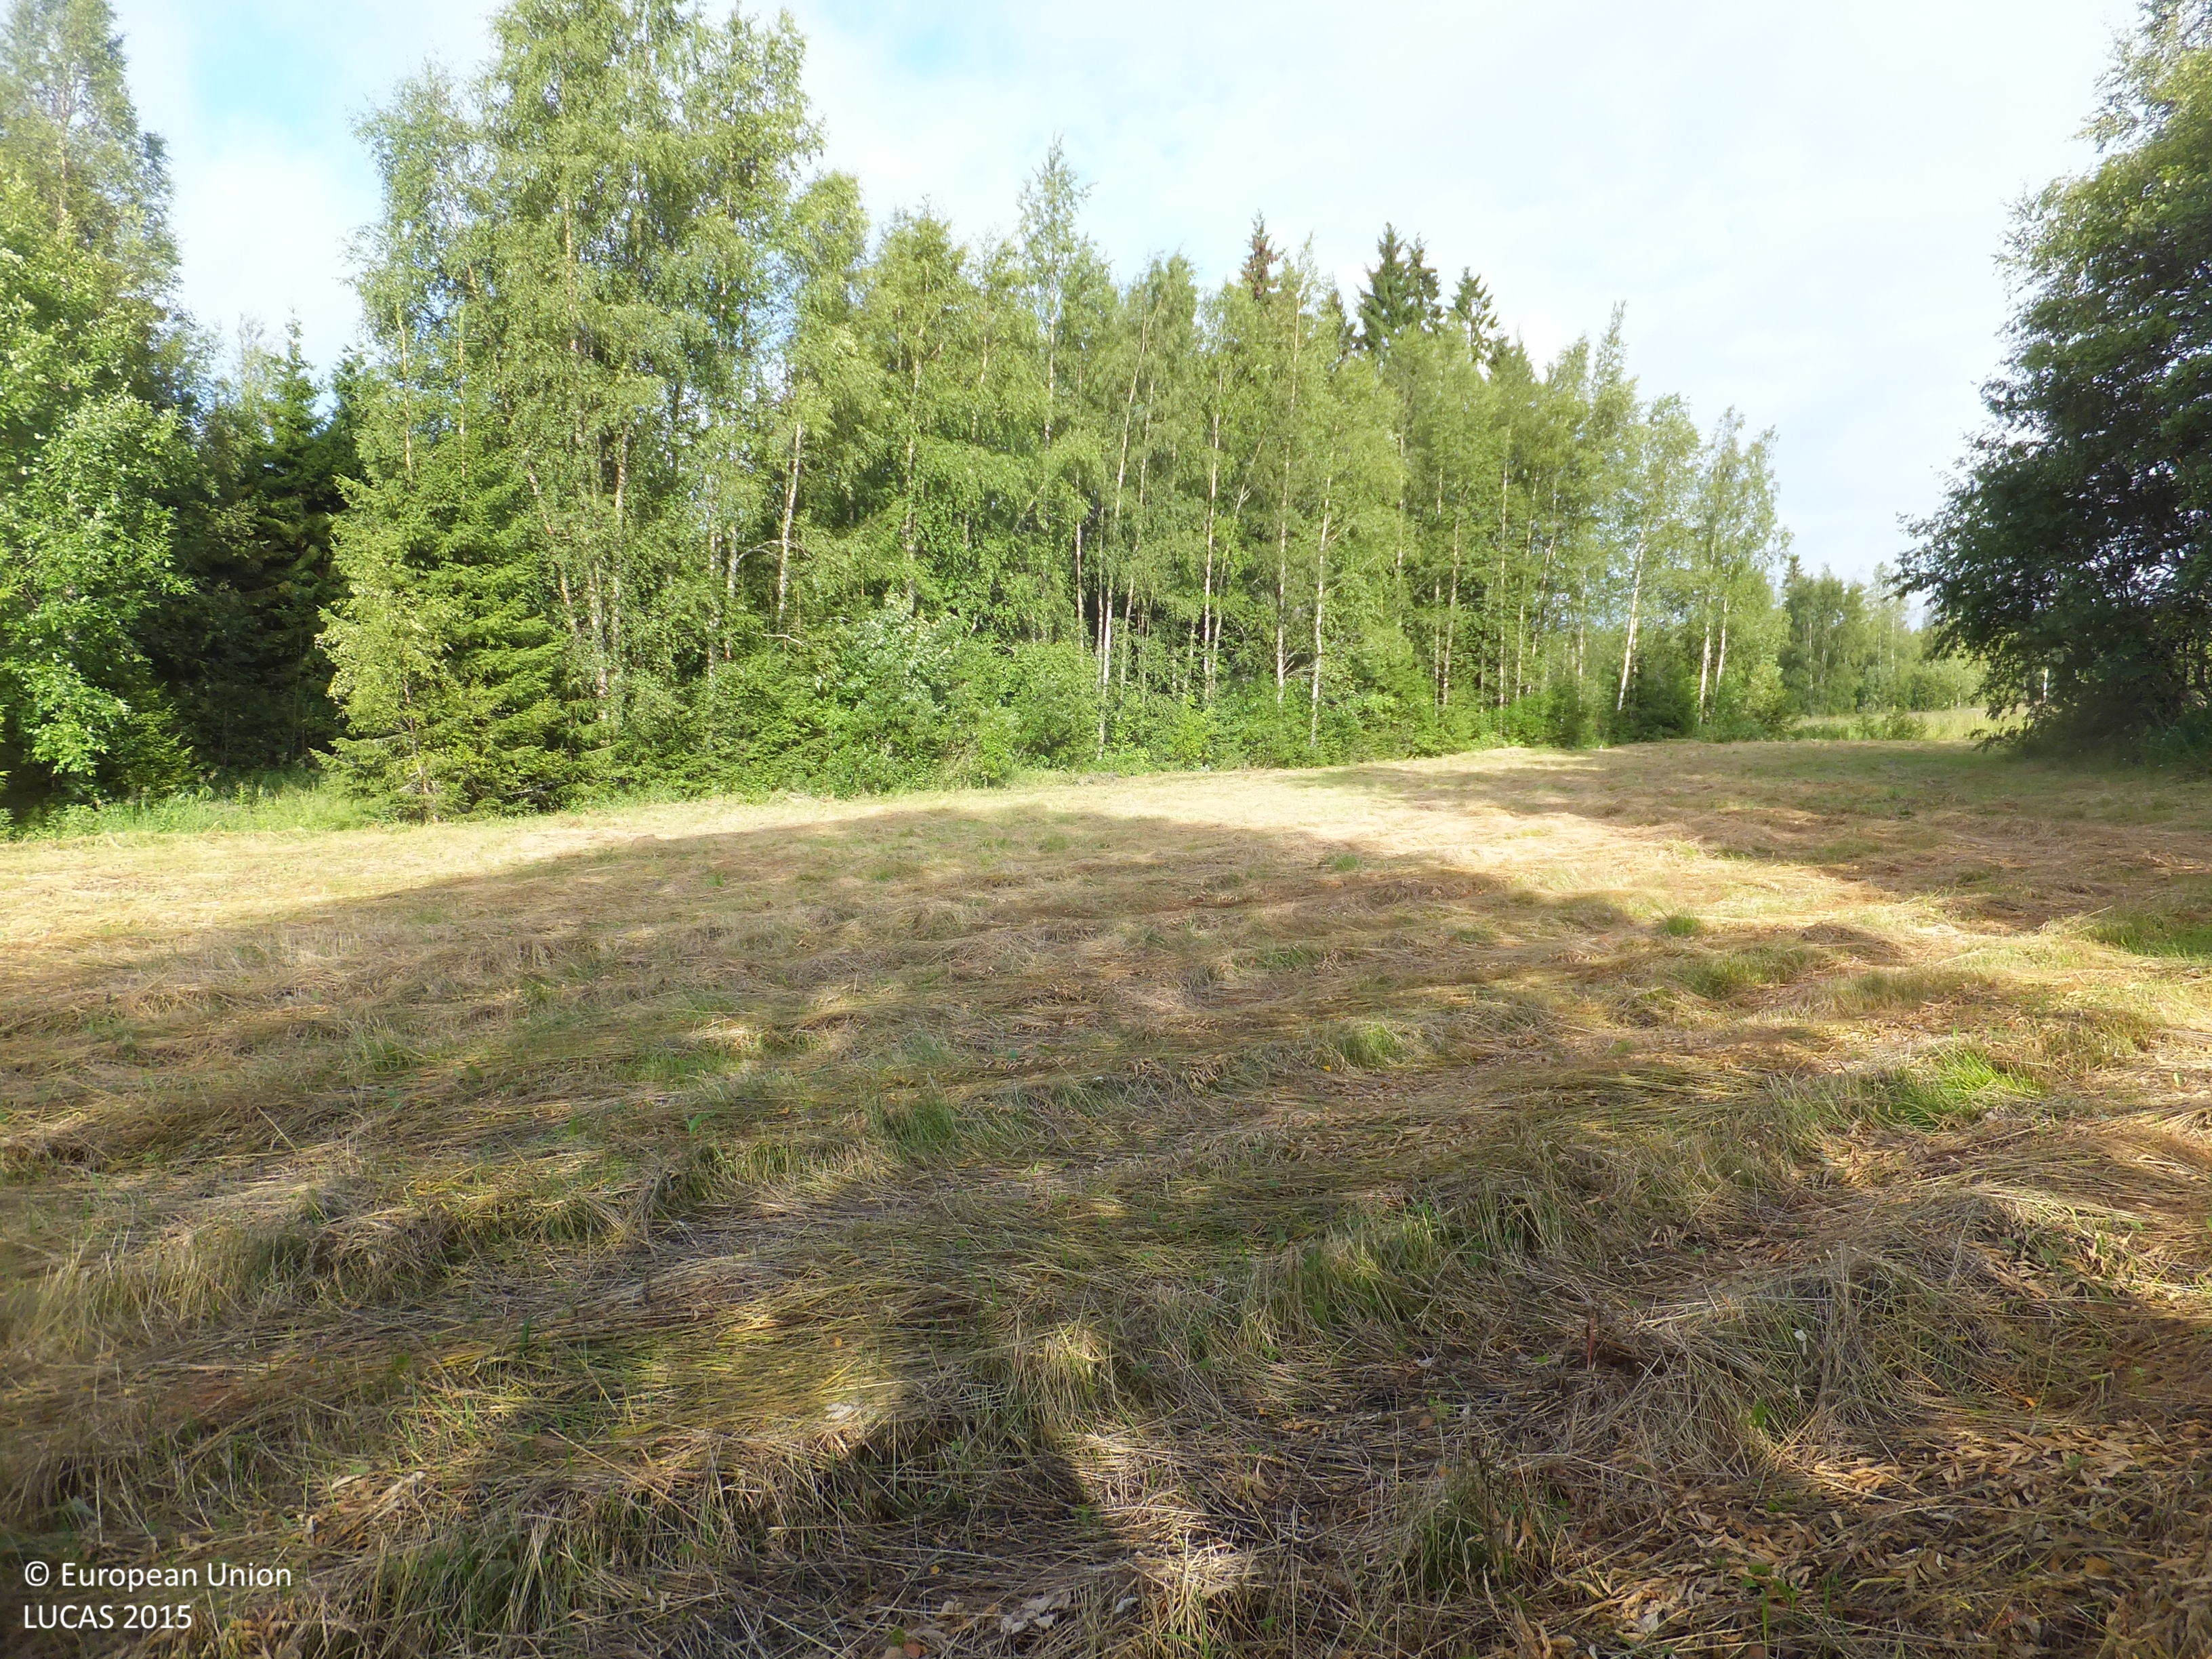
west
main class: Grassland
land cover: Grassland without tree/shrub cover
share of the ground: > 75 %
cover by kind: herbaceous plants 100 %
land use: Agriculture (excluding fallow land and kitchen gardens)
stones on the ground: < 10 %
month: July
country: FI
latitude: 63.1422
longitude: 21.6866
